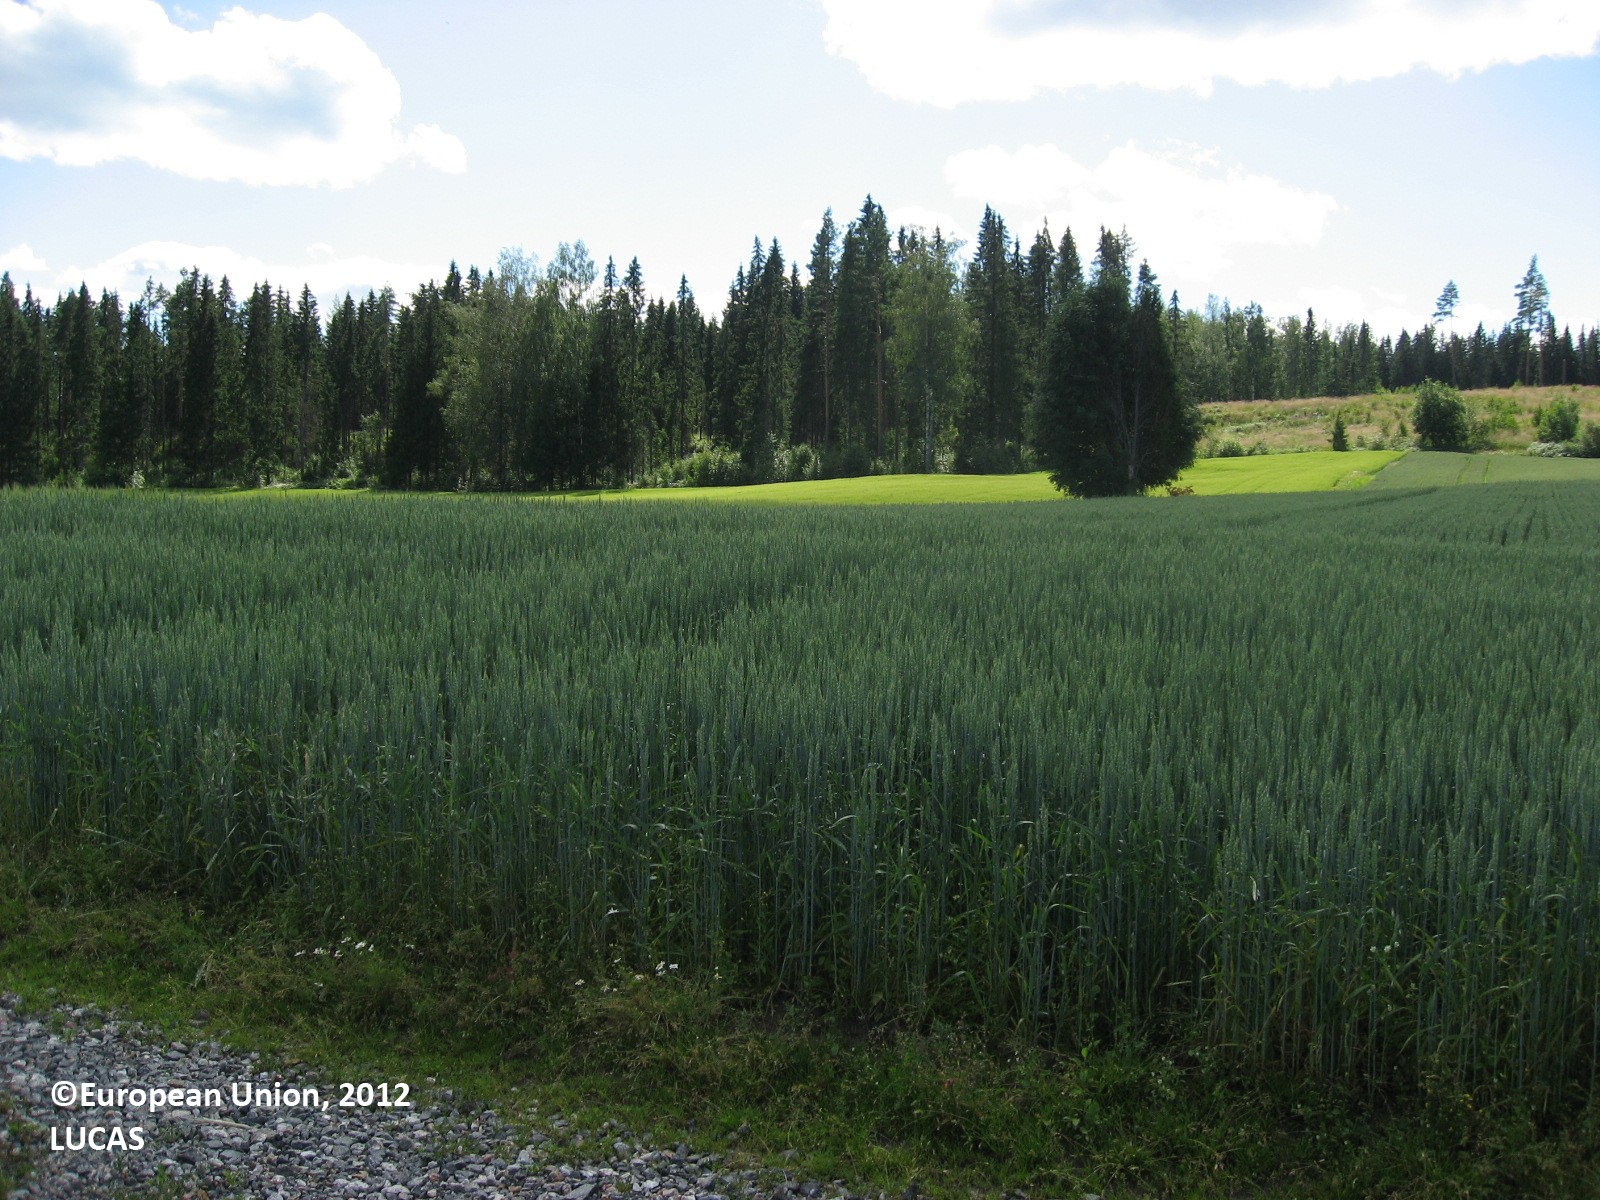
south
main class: Cropland
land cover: Common wheat
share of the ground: > 75 %
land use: Agriculture (excluding fallow land and kitchen gardens)
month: July
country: FI
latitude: 61.2086
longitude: 25.3644
